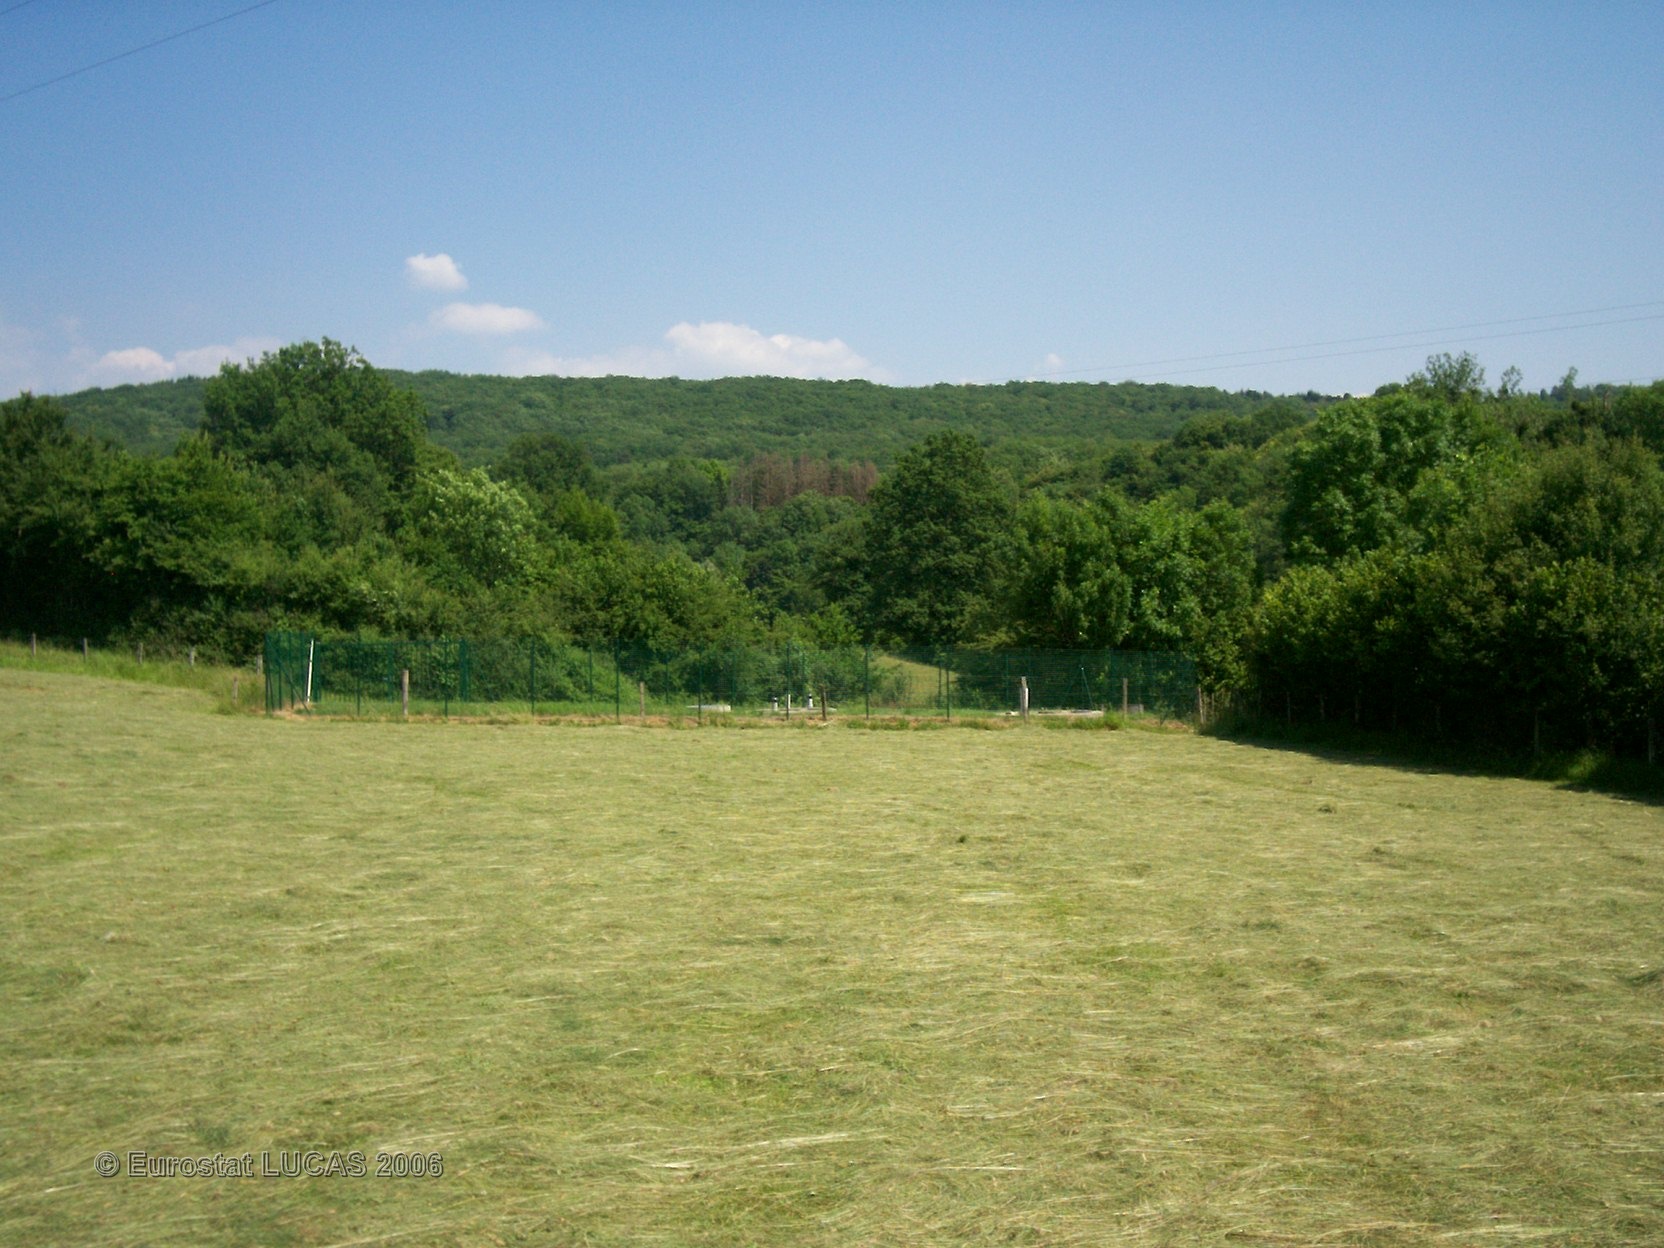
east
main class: Grassland
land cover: Grassland without tree/shrub cover
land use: Agriculture (excluding fallow land and kitchen gardens)
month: June
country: FR
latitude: 46.1073
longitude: 5.3846
